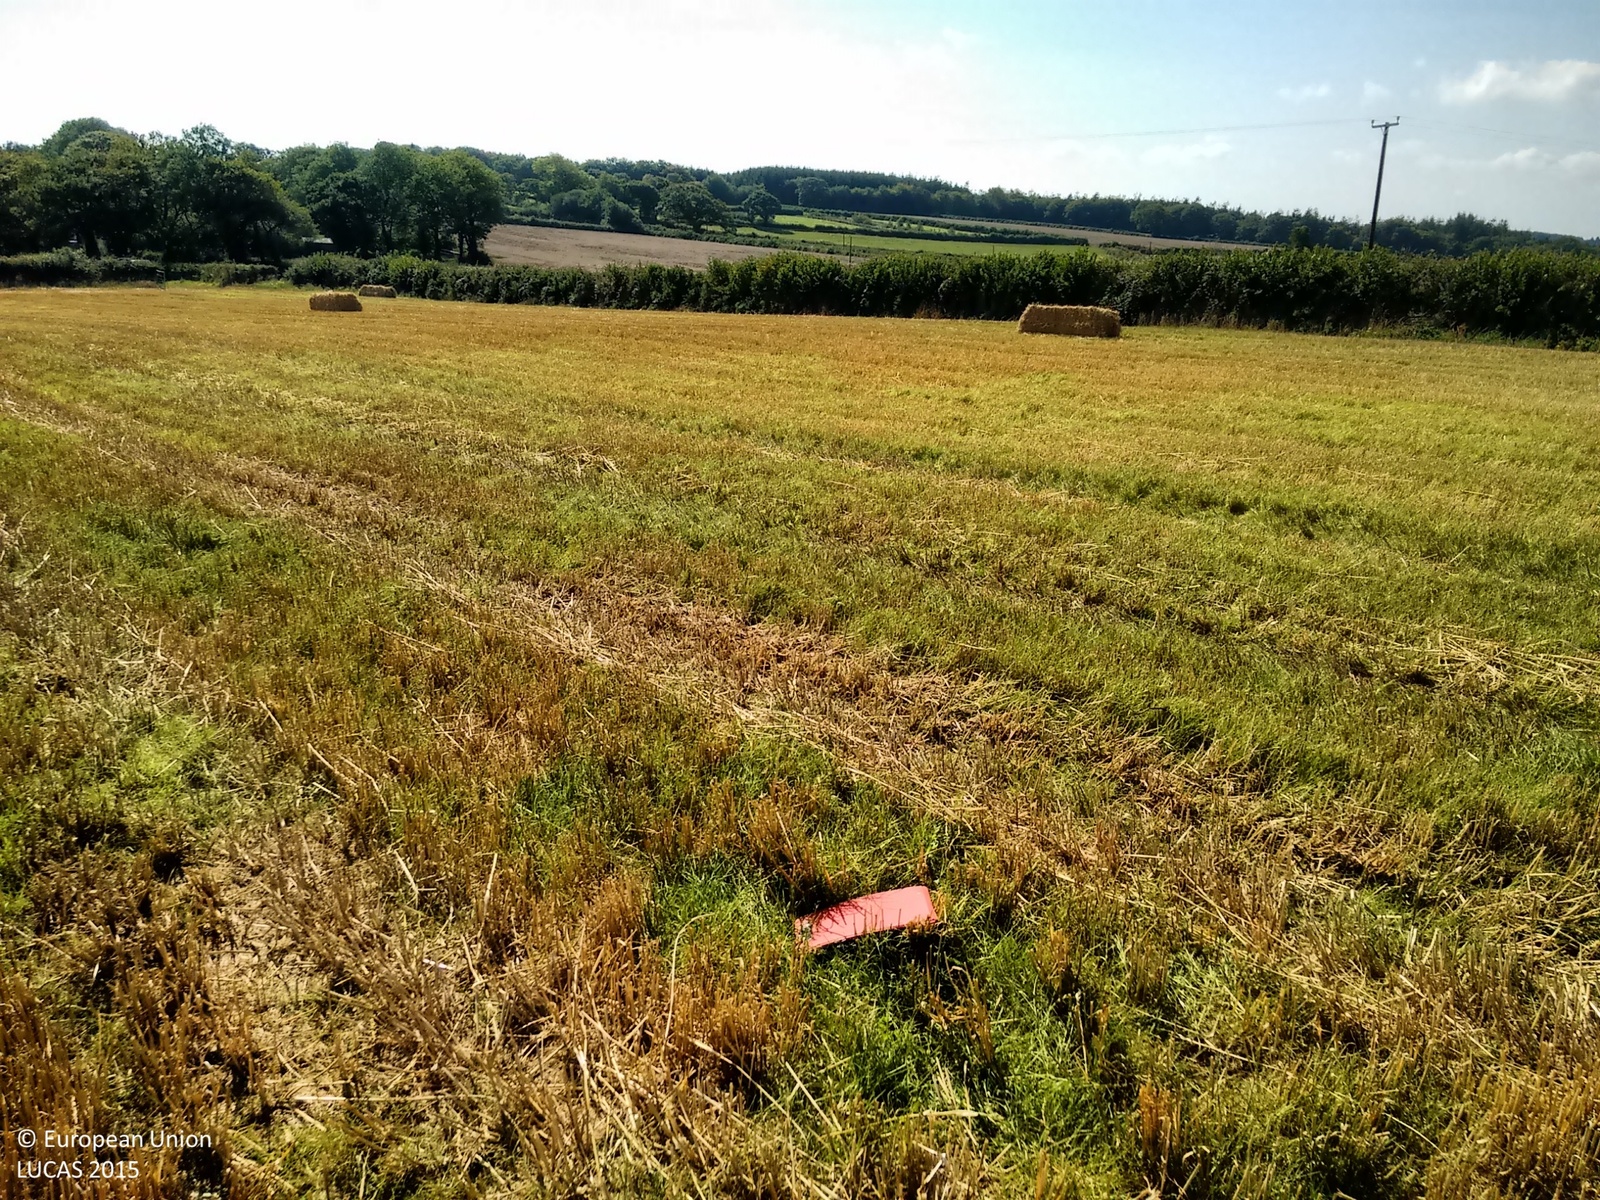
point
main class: Cropland
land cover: Barley
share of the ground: > 75 %
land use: Agriculture (excluding fallow land and kitchen gardens)
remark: Harvested field
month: September
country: GB
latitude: 50.8665
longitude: -4.1498
